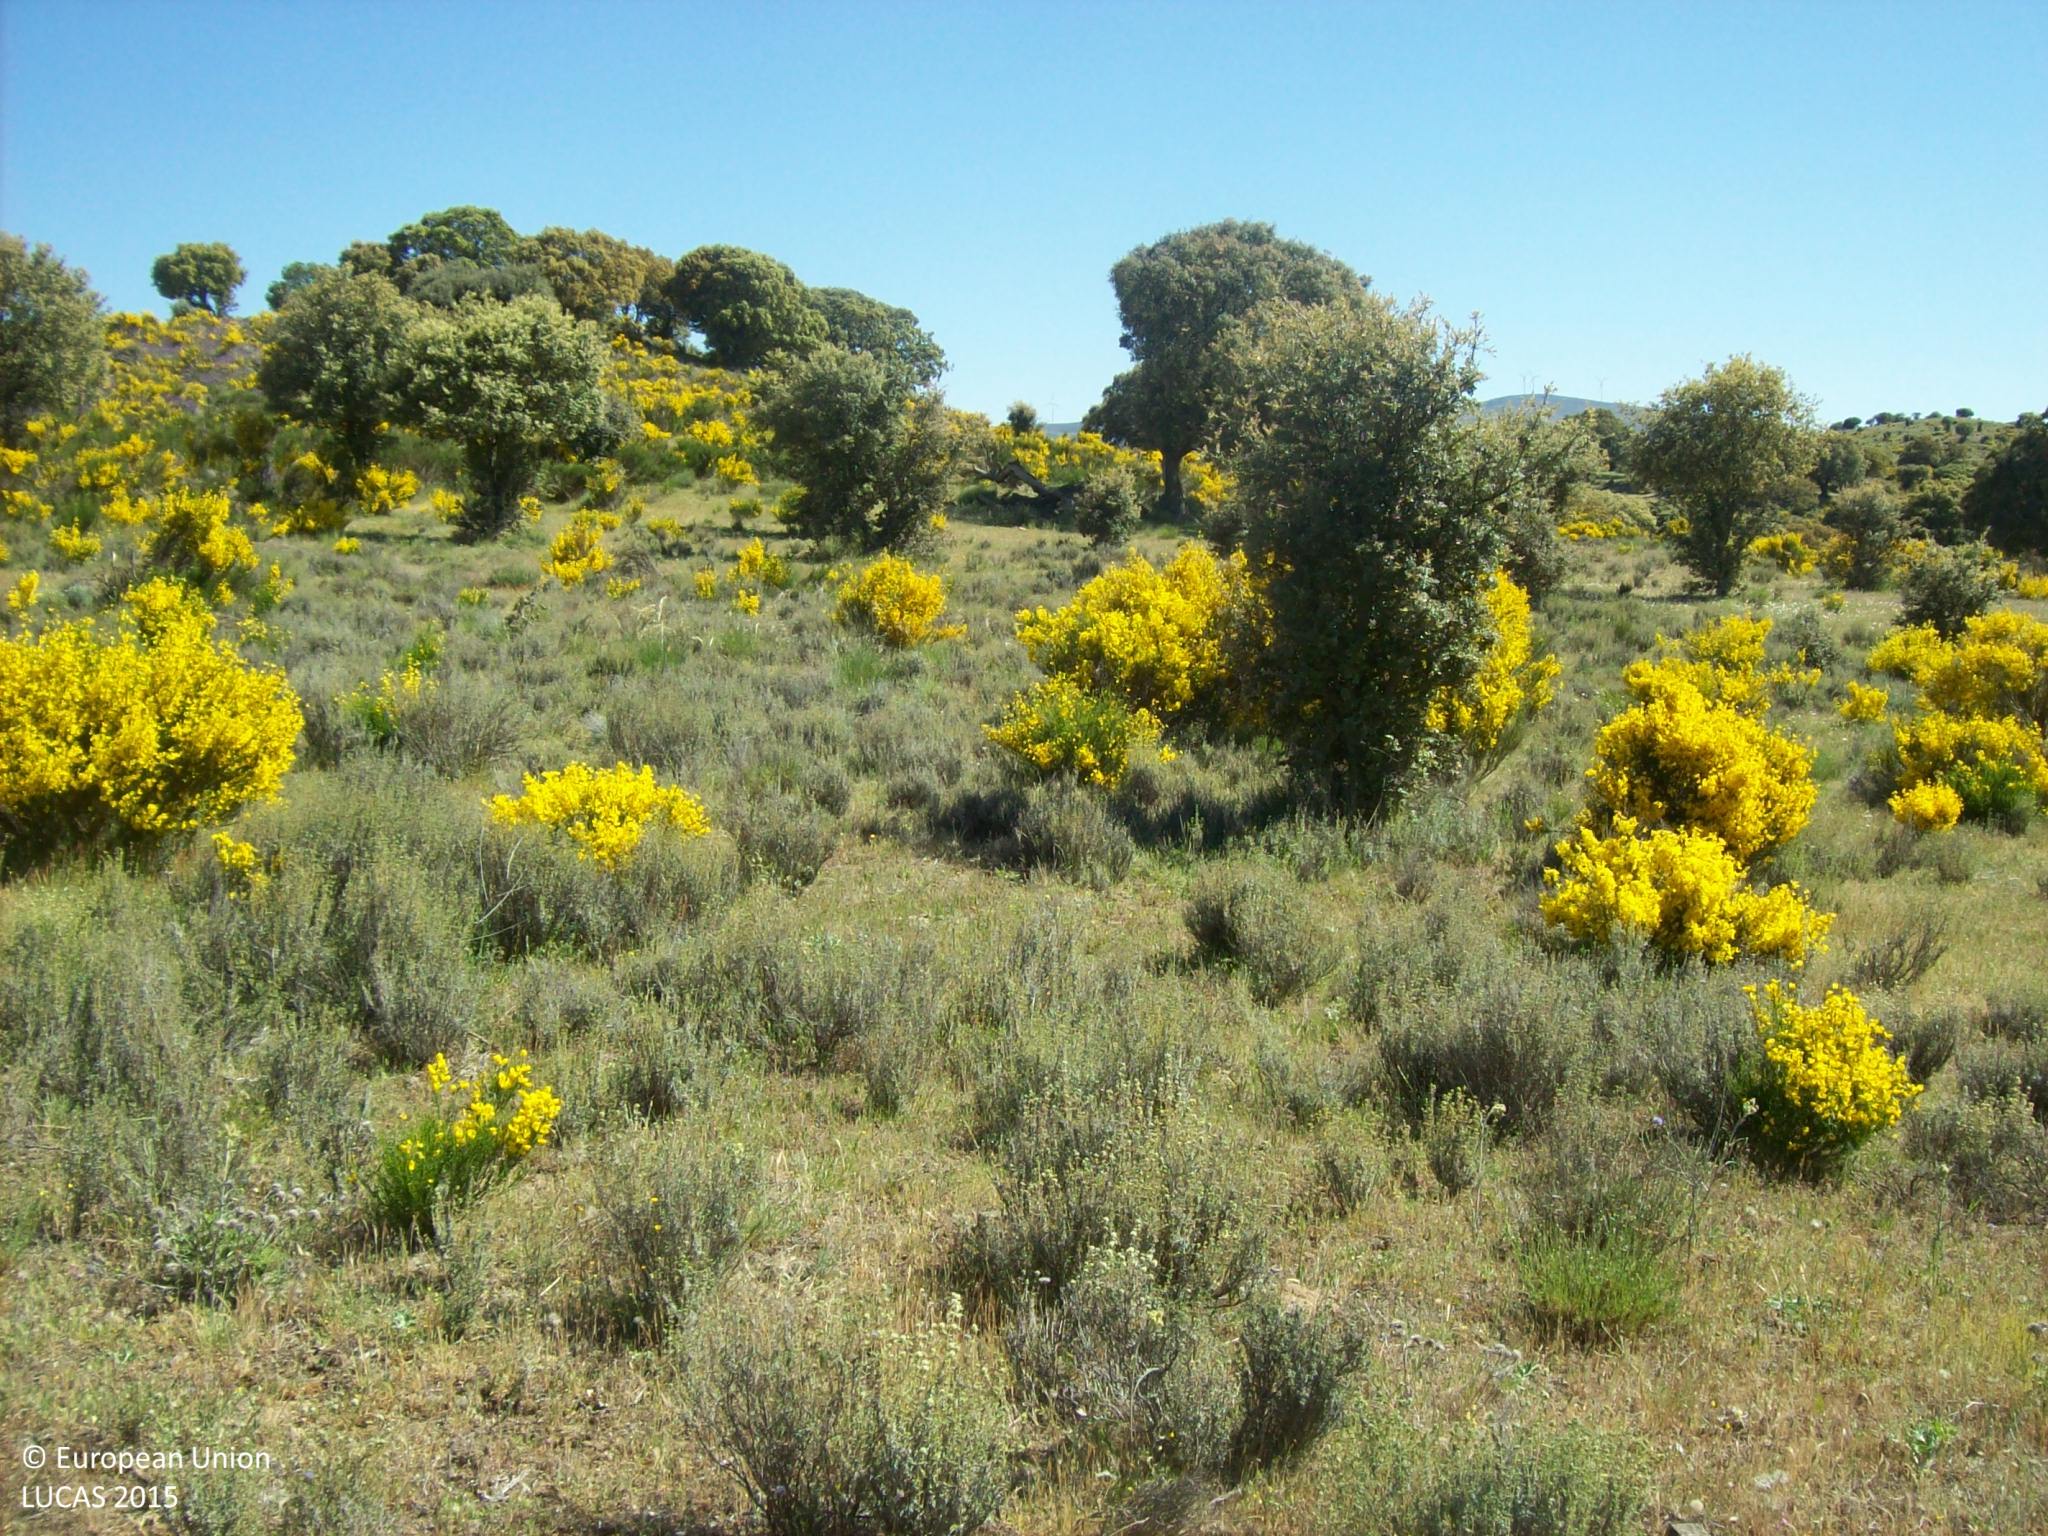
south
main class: Woodland
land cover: Broadleaved woodland
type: acidophilous oak and oak-birch forest
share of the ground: 10 - 25 %
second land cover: Shrubland without tree cover
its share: 50 - 75 %
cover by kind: shrubs 40 %, herbaceous plants 40 %, broadleaved forest trees 10 %, lichens and mosses 10 %
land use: Forestry
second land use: Agriculture (excluding fallow land and kitchen gardens)
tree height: > 5 m
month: May
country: ES
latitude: 40.7275
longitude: -4.9674
